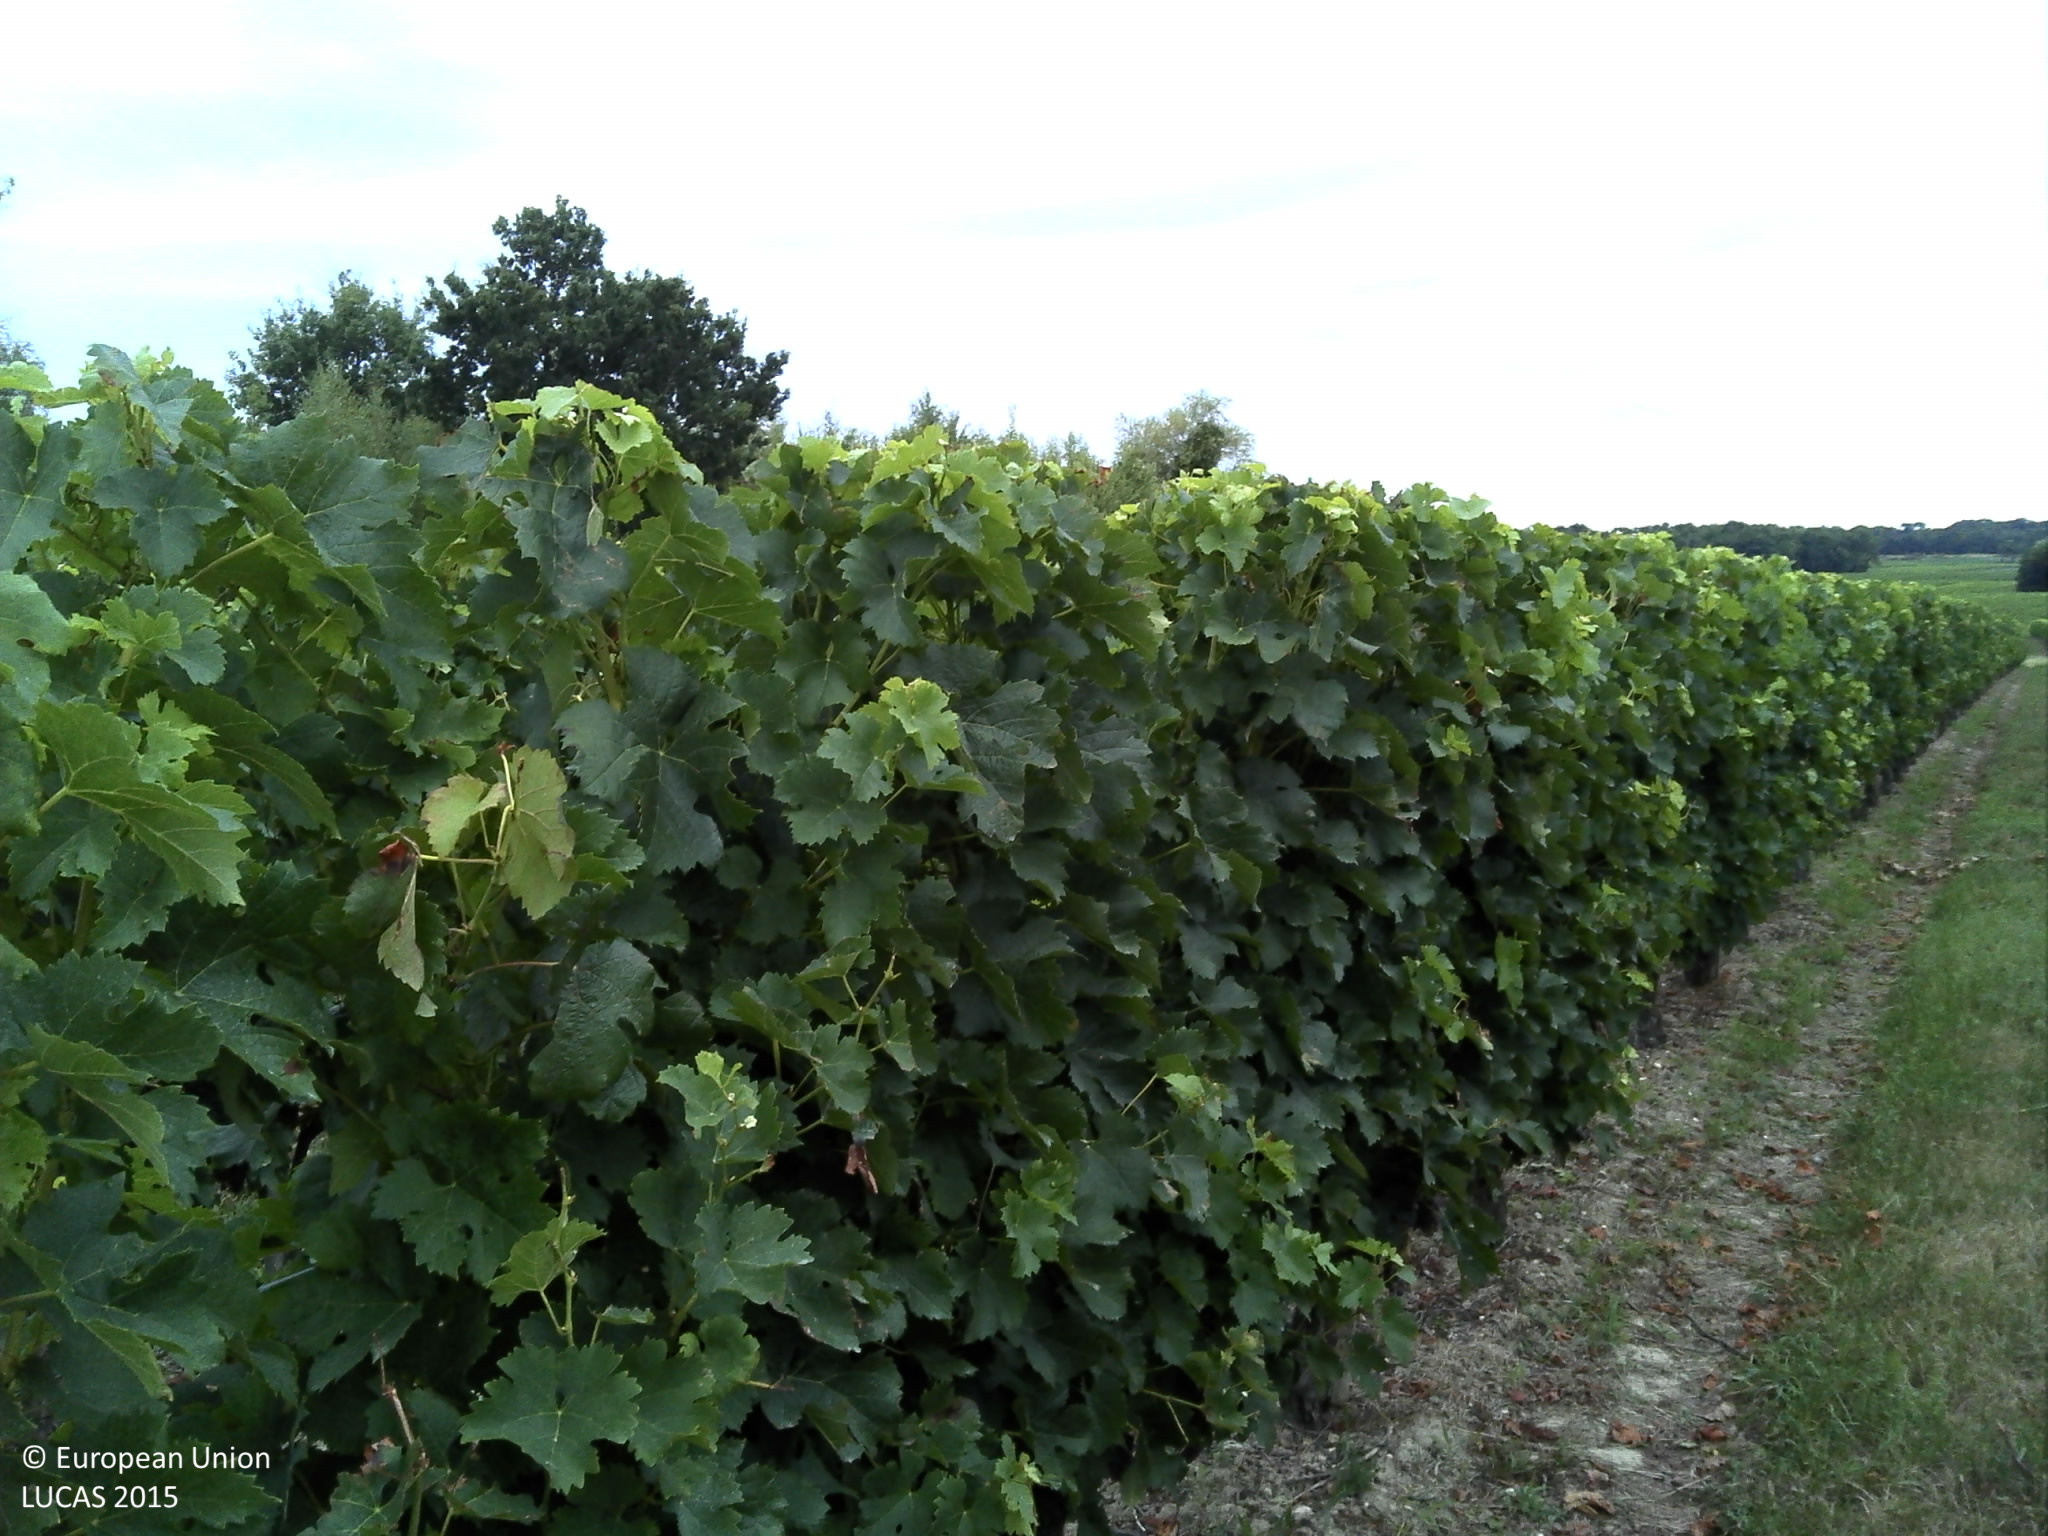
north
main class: Cropland
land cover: Vineyards
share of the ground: 25 - 50 %
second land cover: Grassland without tree/shrub cover
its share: > 75 %
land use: Agriculture (excluding fallow land and kitchen gardens)
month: August
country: FR
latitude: 45.1035
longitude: -0.5298
